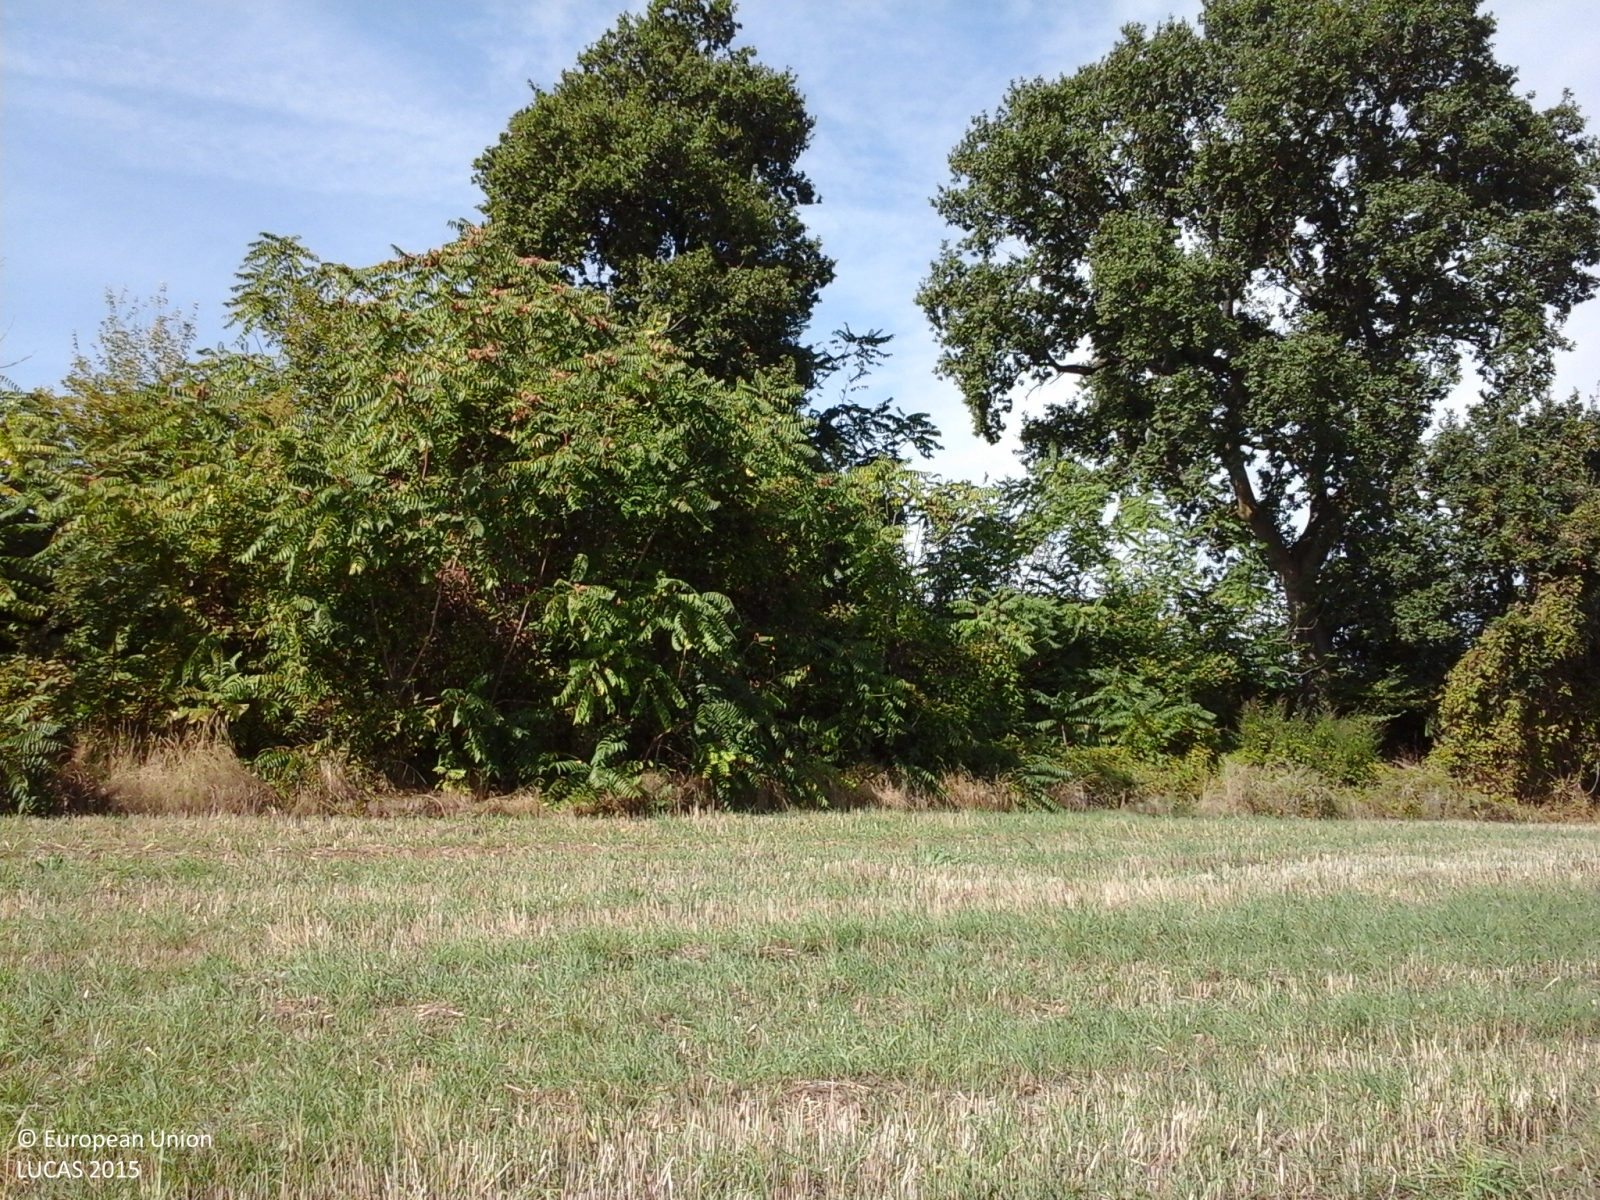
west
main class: Cropland
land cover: Common wheat
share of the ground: > 75 %
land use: Agriculture (excluding fallow land and kitchen gardens)
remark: Harvested field
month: September
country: IT
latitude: 42.8522
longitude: 13.8442
